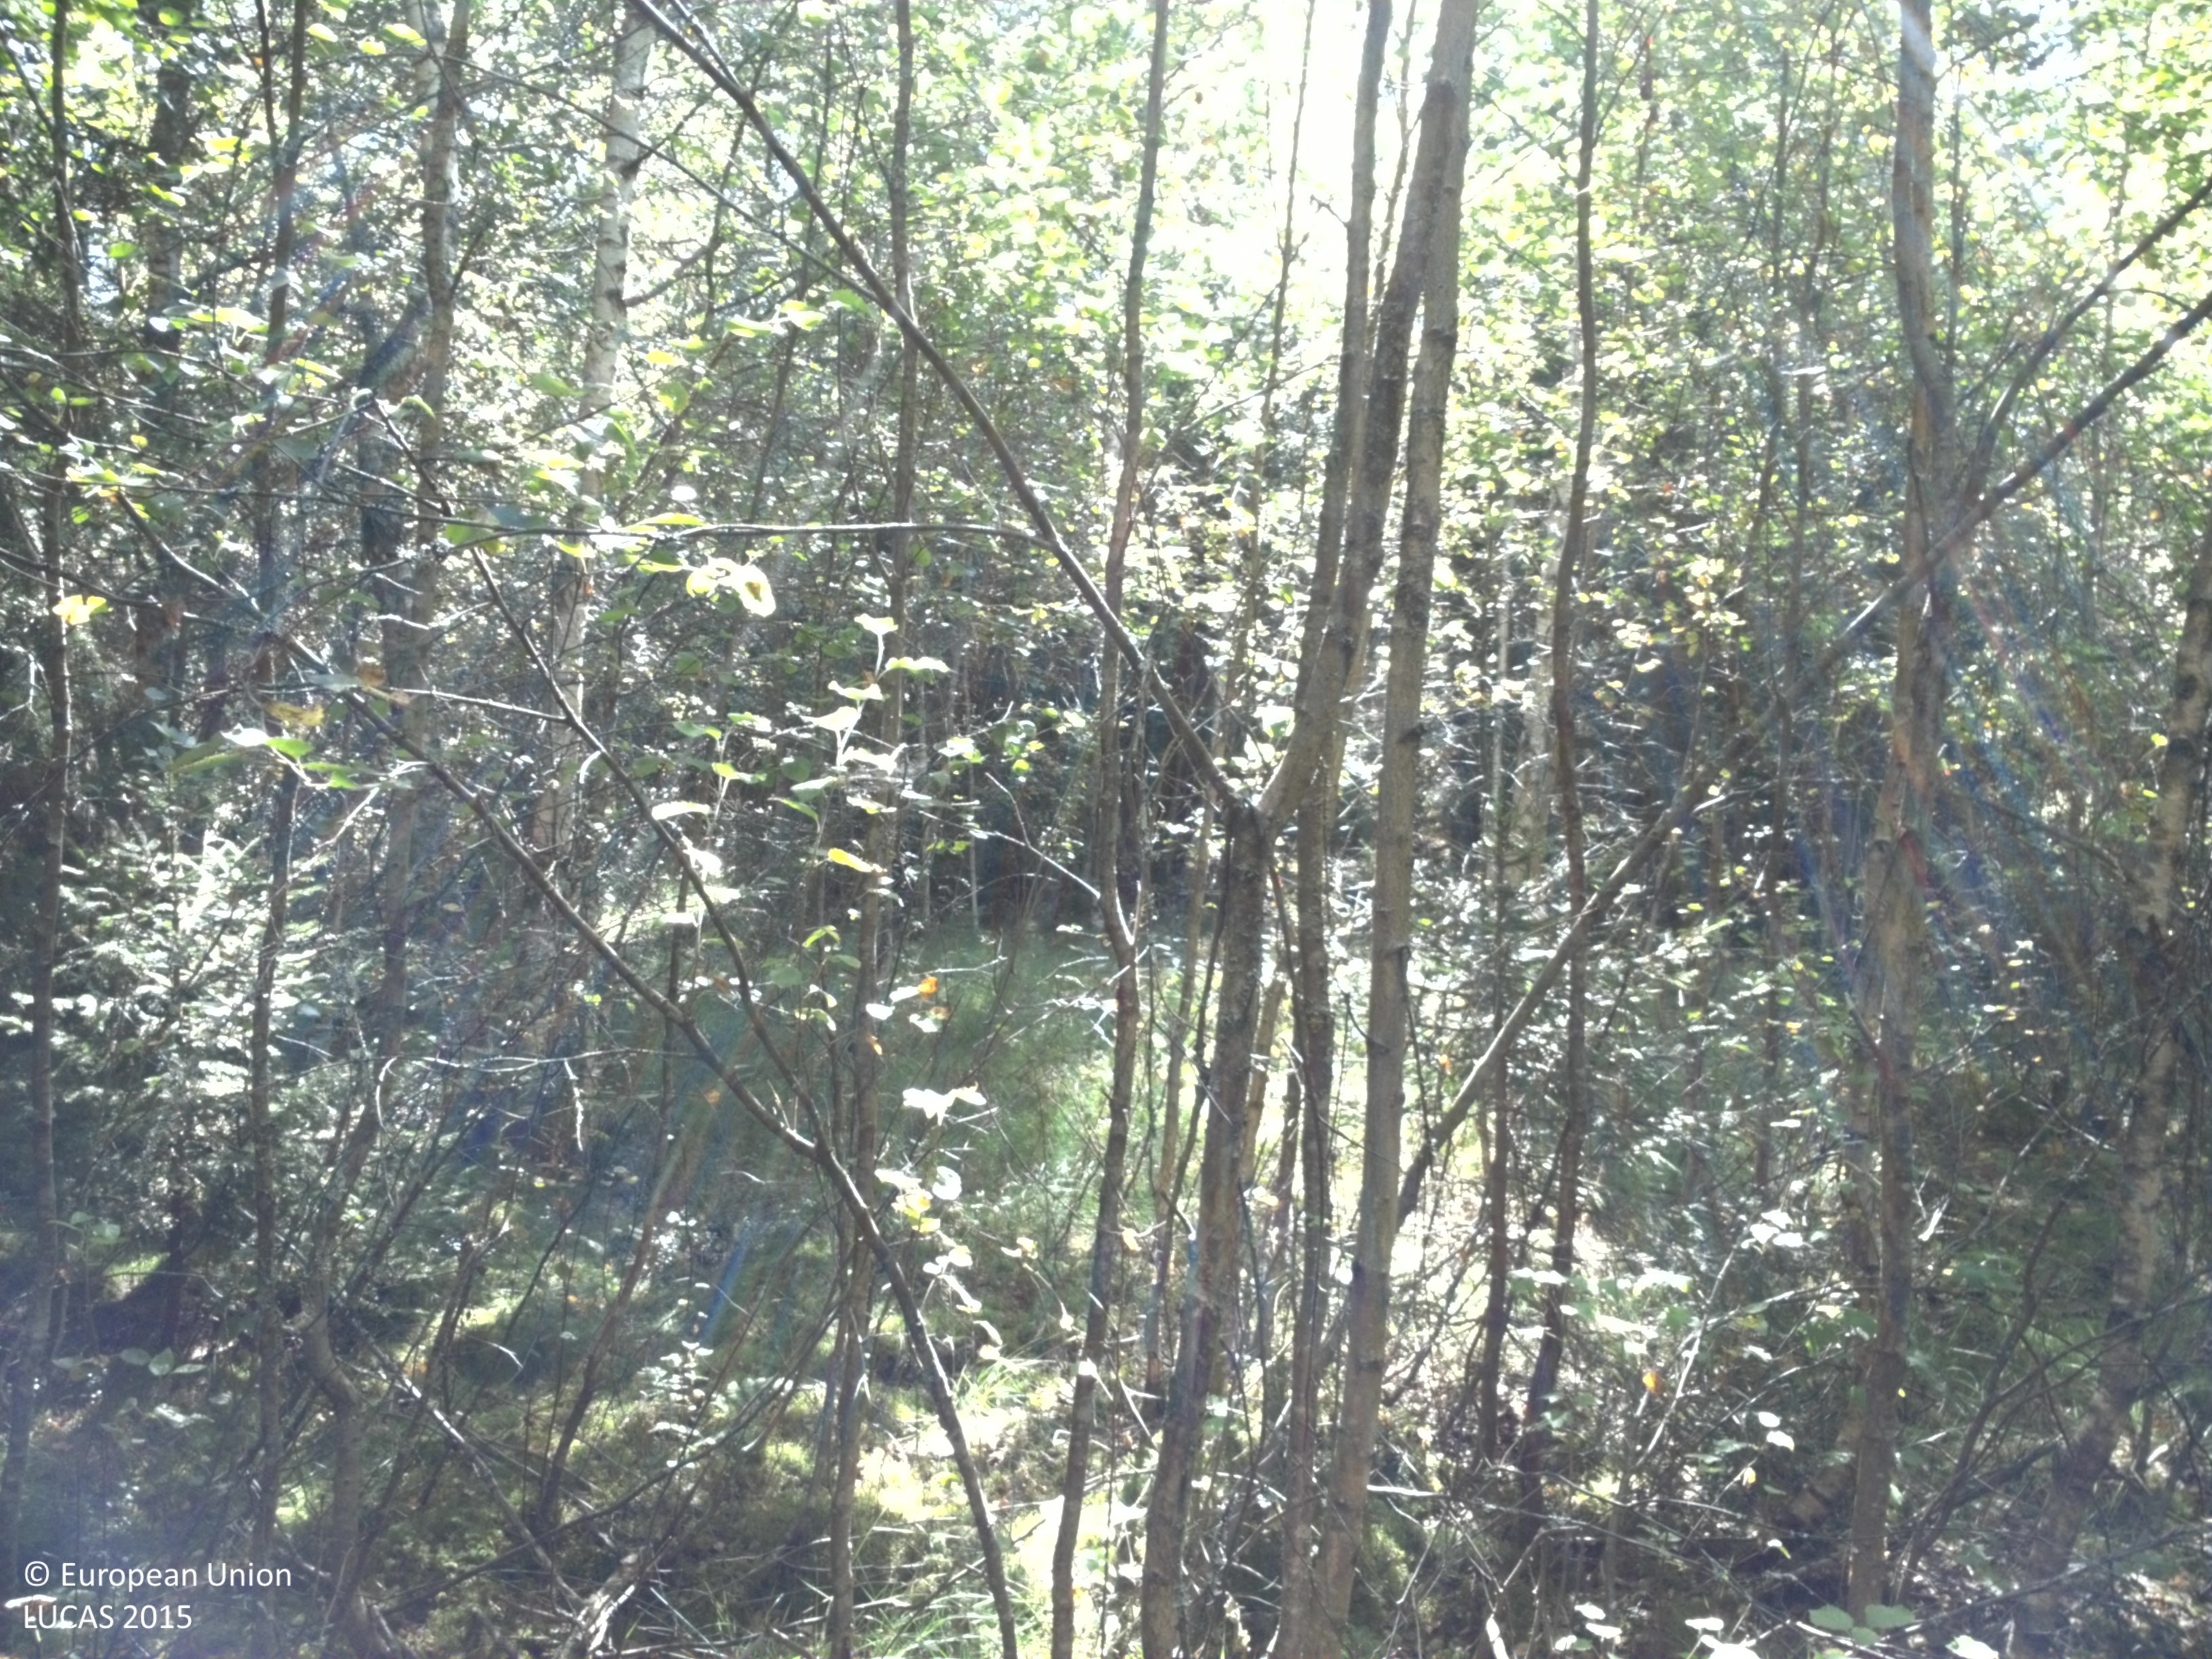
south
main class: Woodland
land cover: Spruce dominated mixed woodland
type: boreal forest
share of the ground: > 75 %
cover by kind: coniferous forest trees 65 %, broadleaved forest trees 25 %, herbaceous plants 5 %, lichens and mosses 5 %
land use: Forestry
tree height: > 5 m
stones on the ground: < 10 %
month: August
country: SE
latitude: 59.8040
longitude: 16.7118
